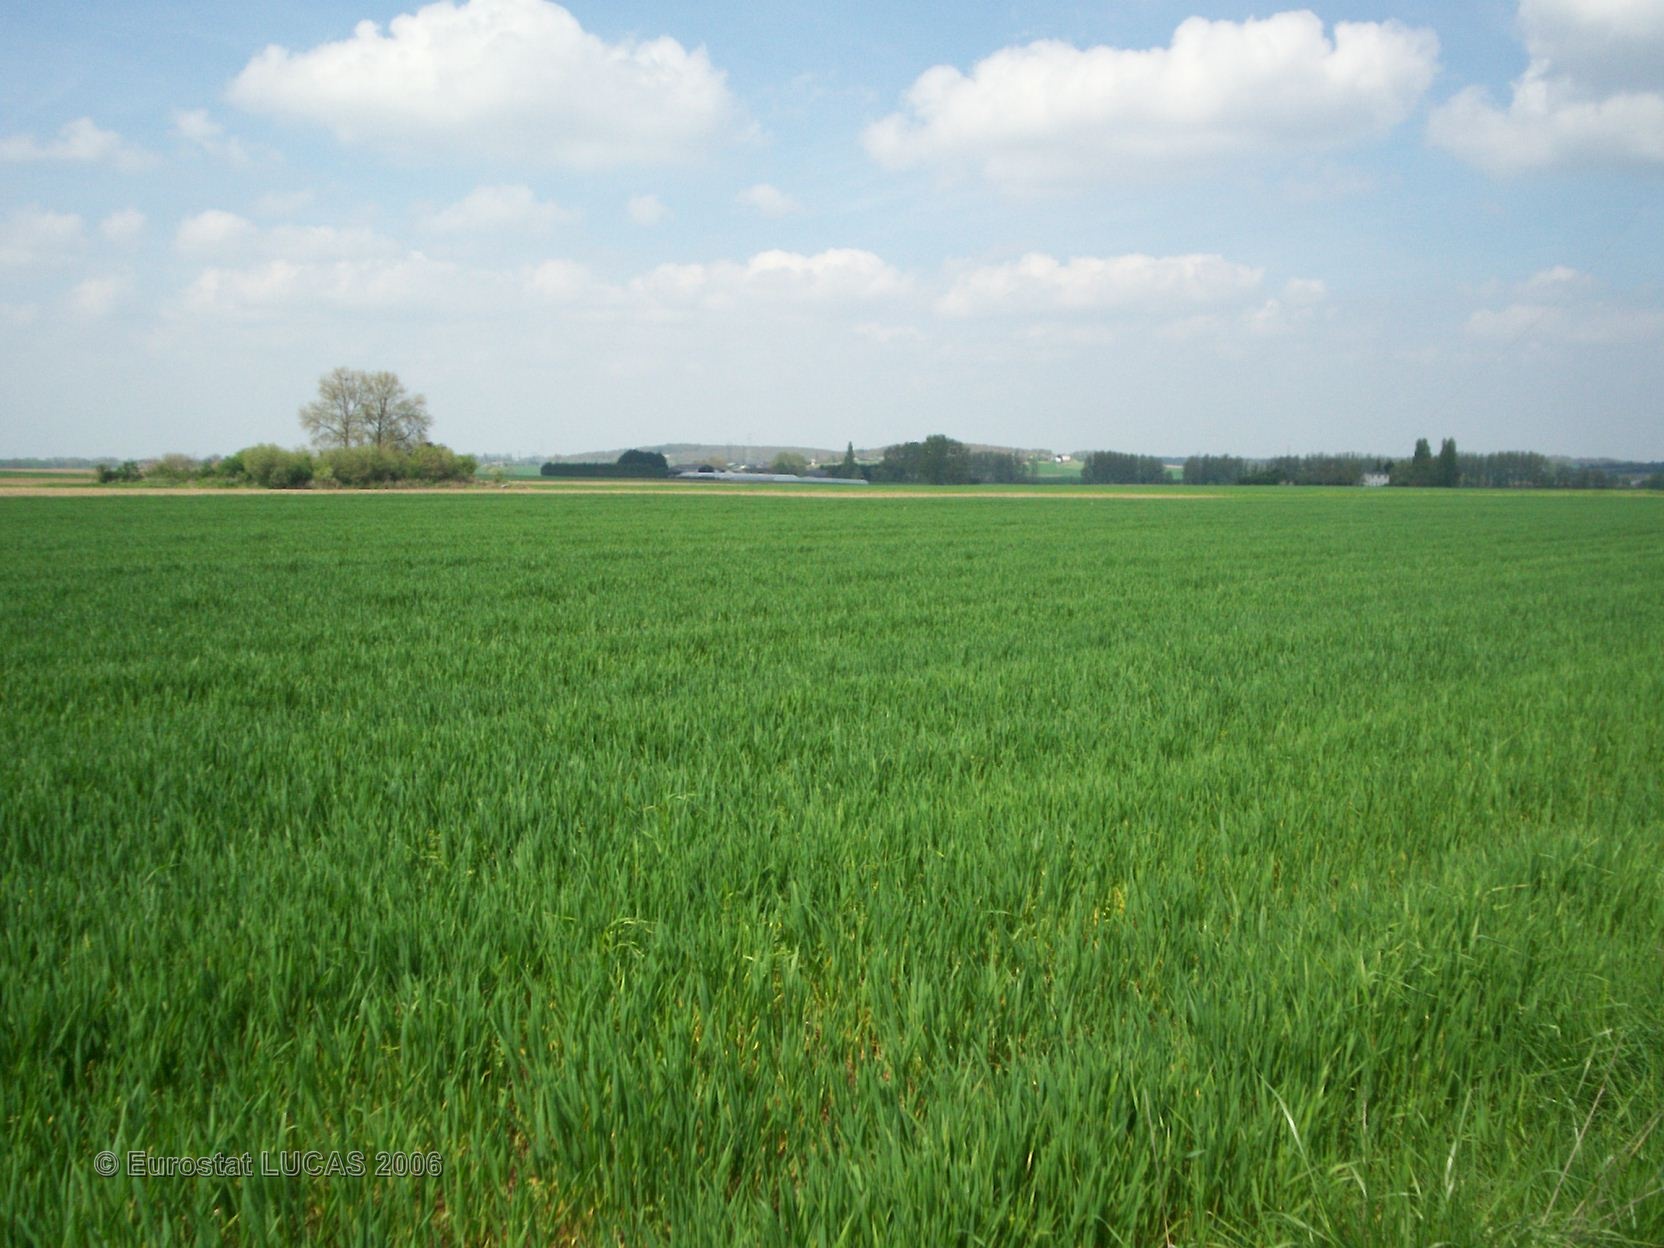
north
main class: Grassland
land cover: Grassland without tree/shrub cover
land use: Agriculture (excluding fallow land and kitchen gardens)
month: April
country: FR
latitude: 47.3320
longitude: -0.3907
